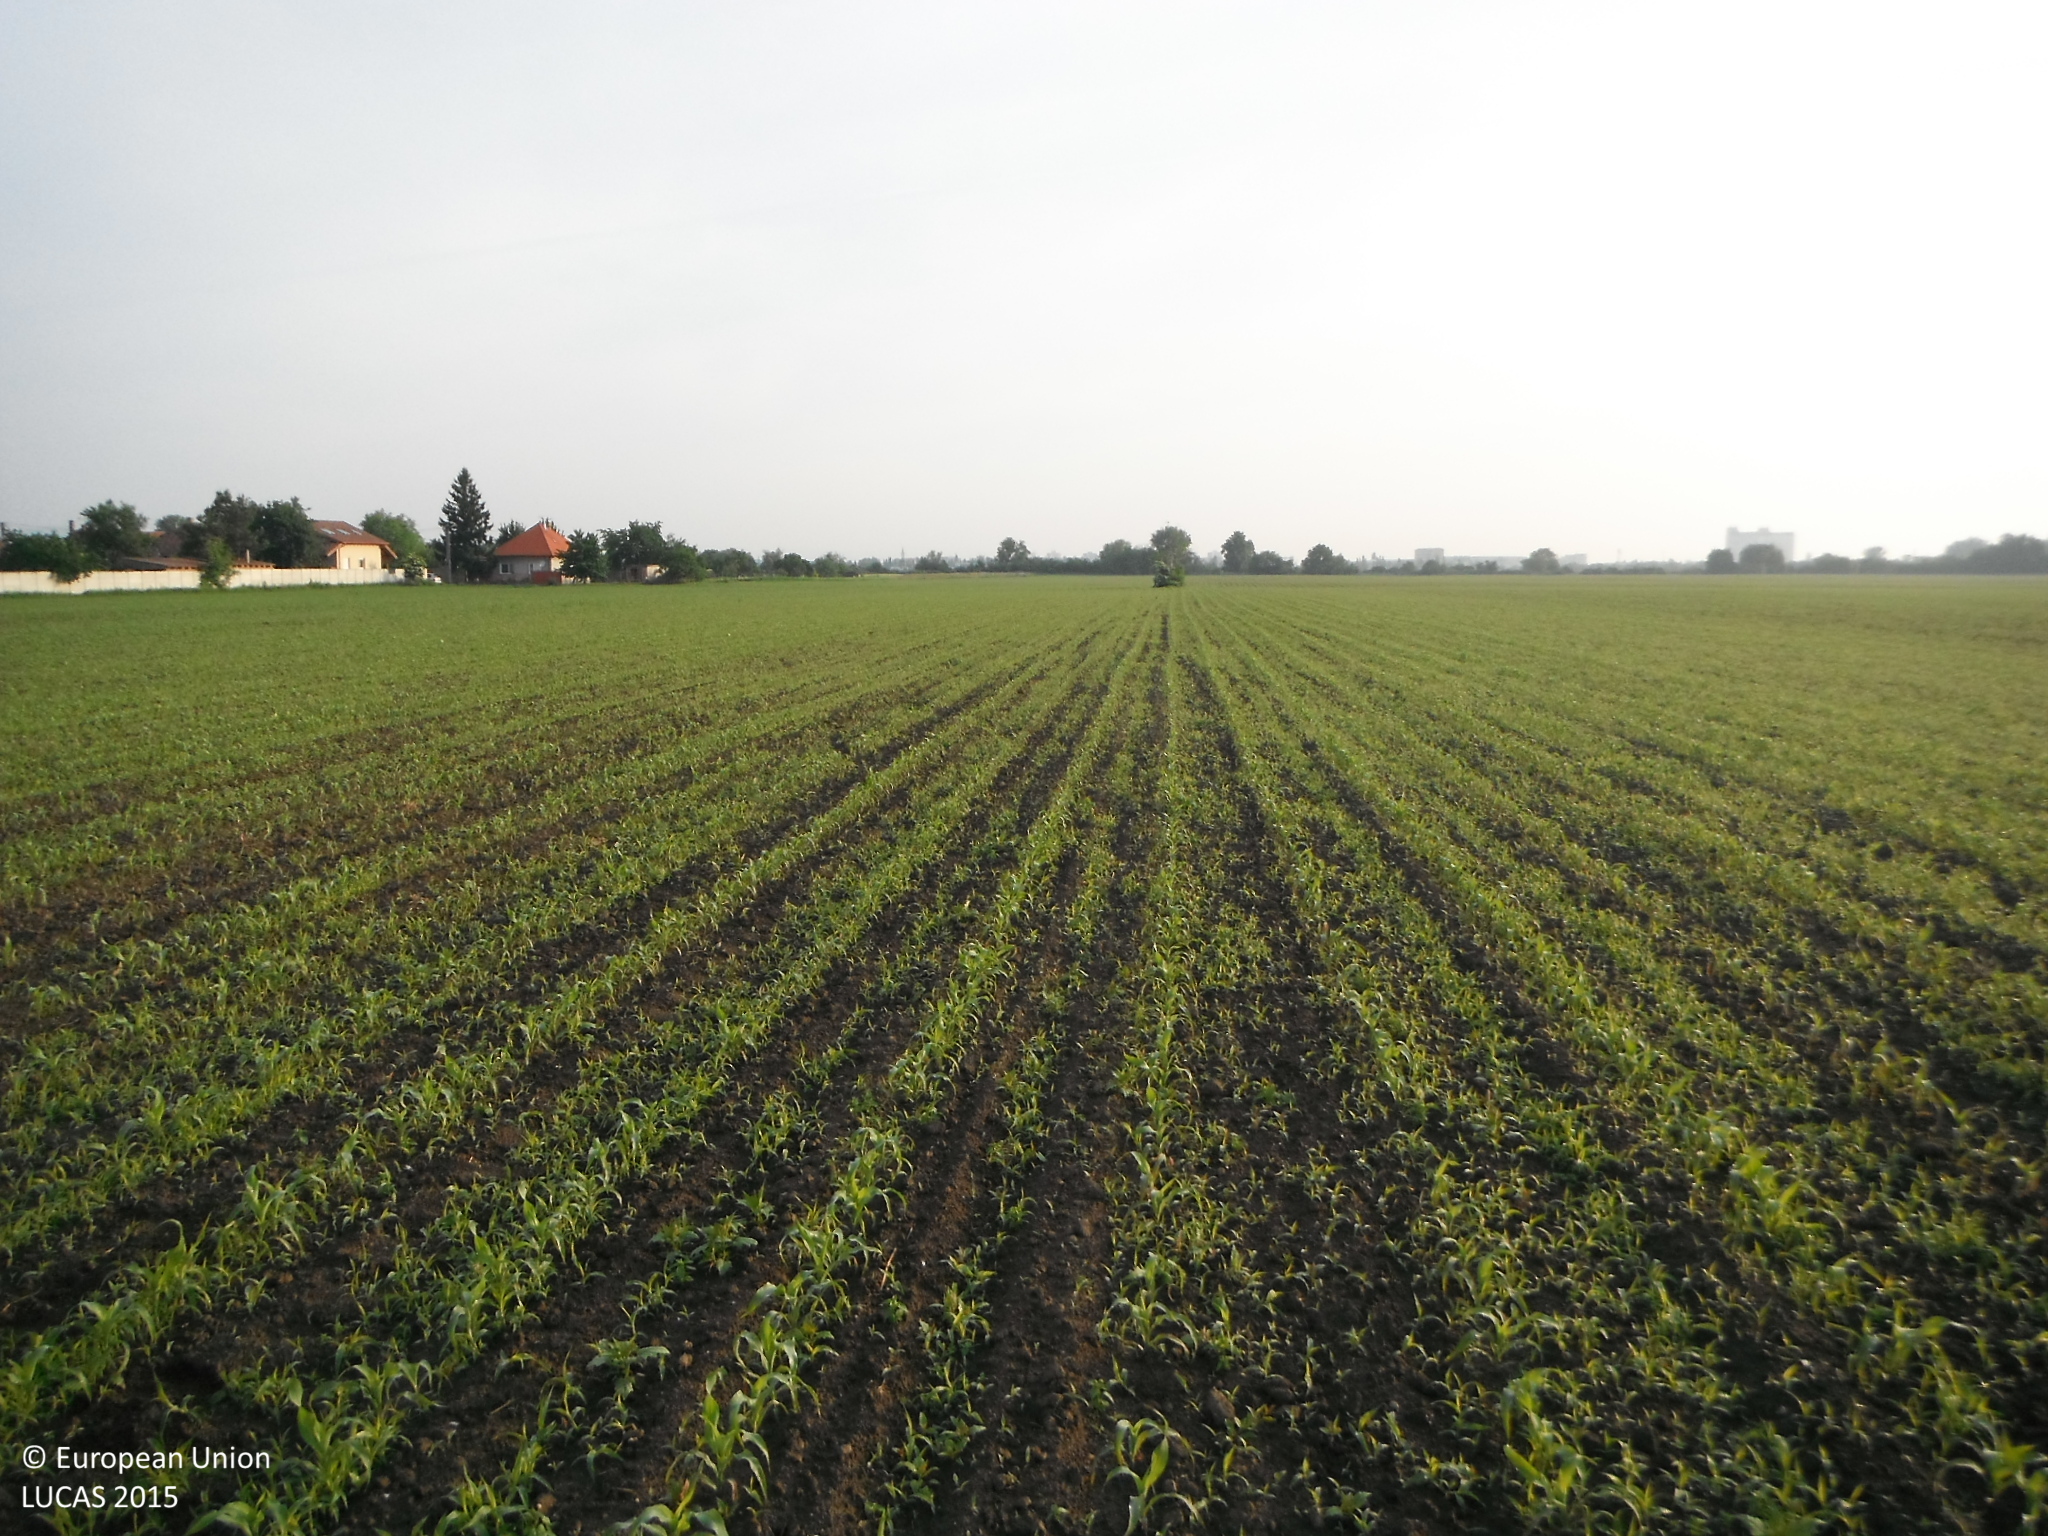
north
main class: Cropland
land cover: Maize
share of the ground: 10 - 25 %
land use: Agriculture (excluding fallow land and kitchen gardens)
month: May
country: SK
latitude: 48.1919
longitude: 17.3948
